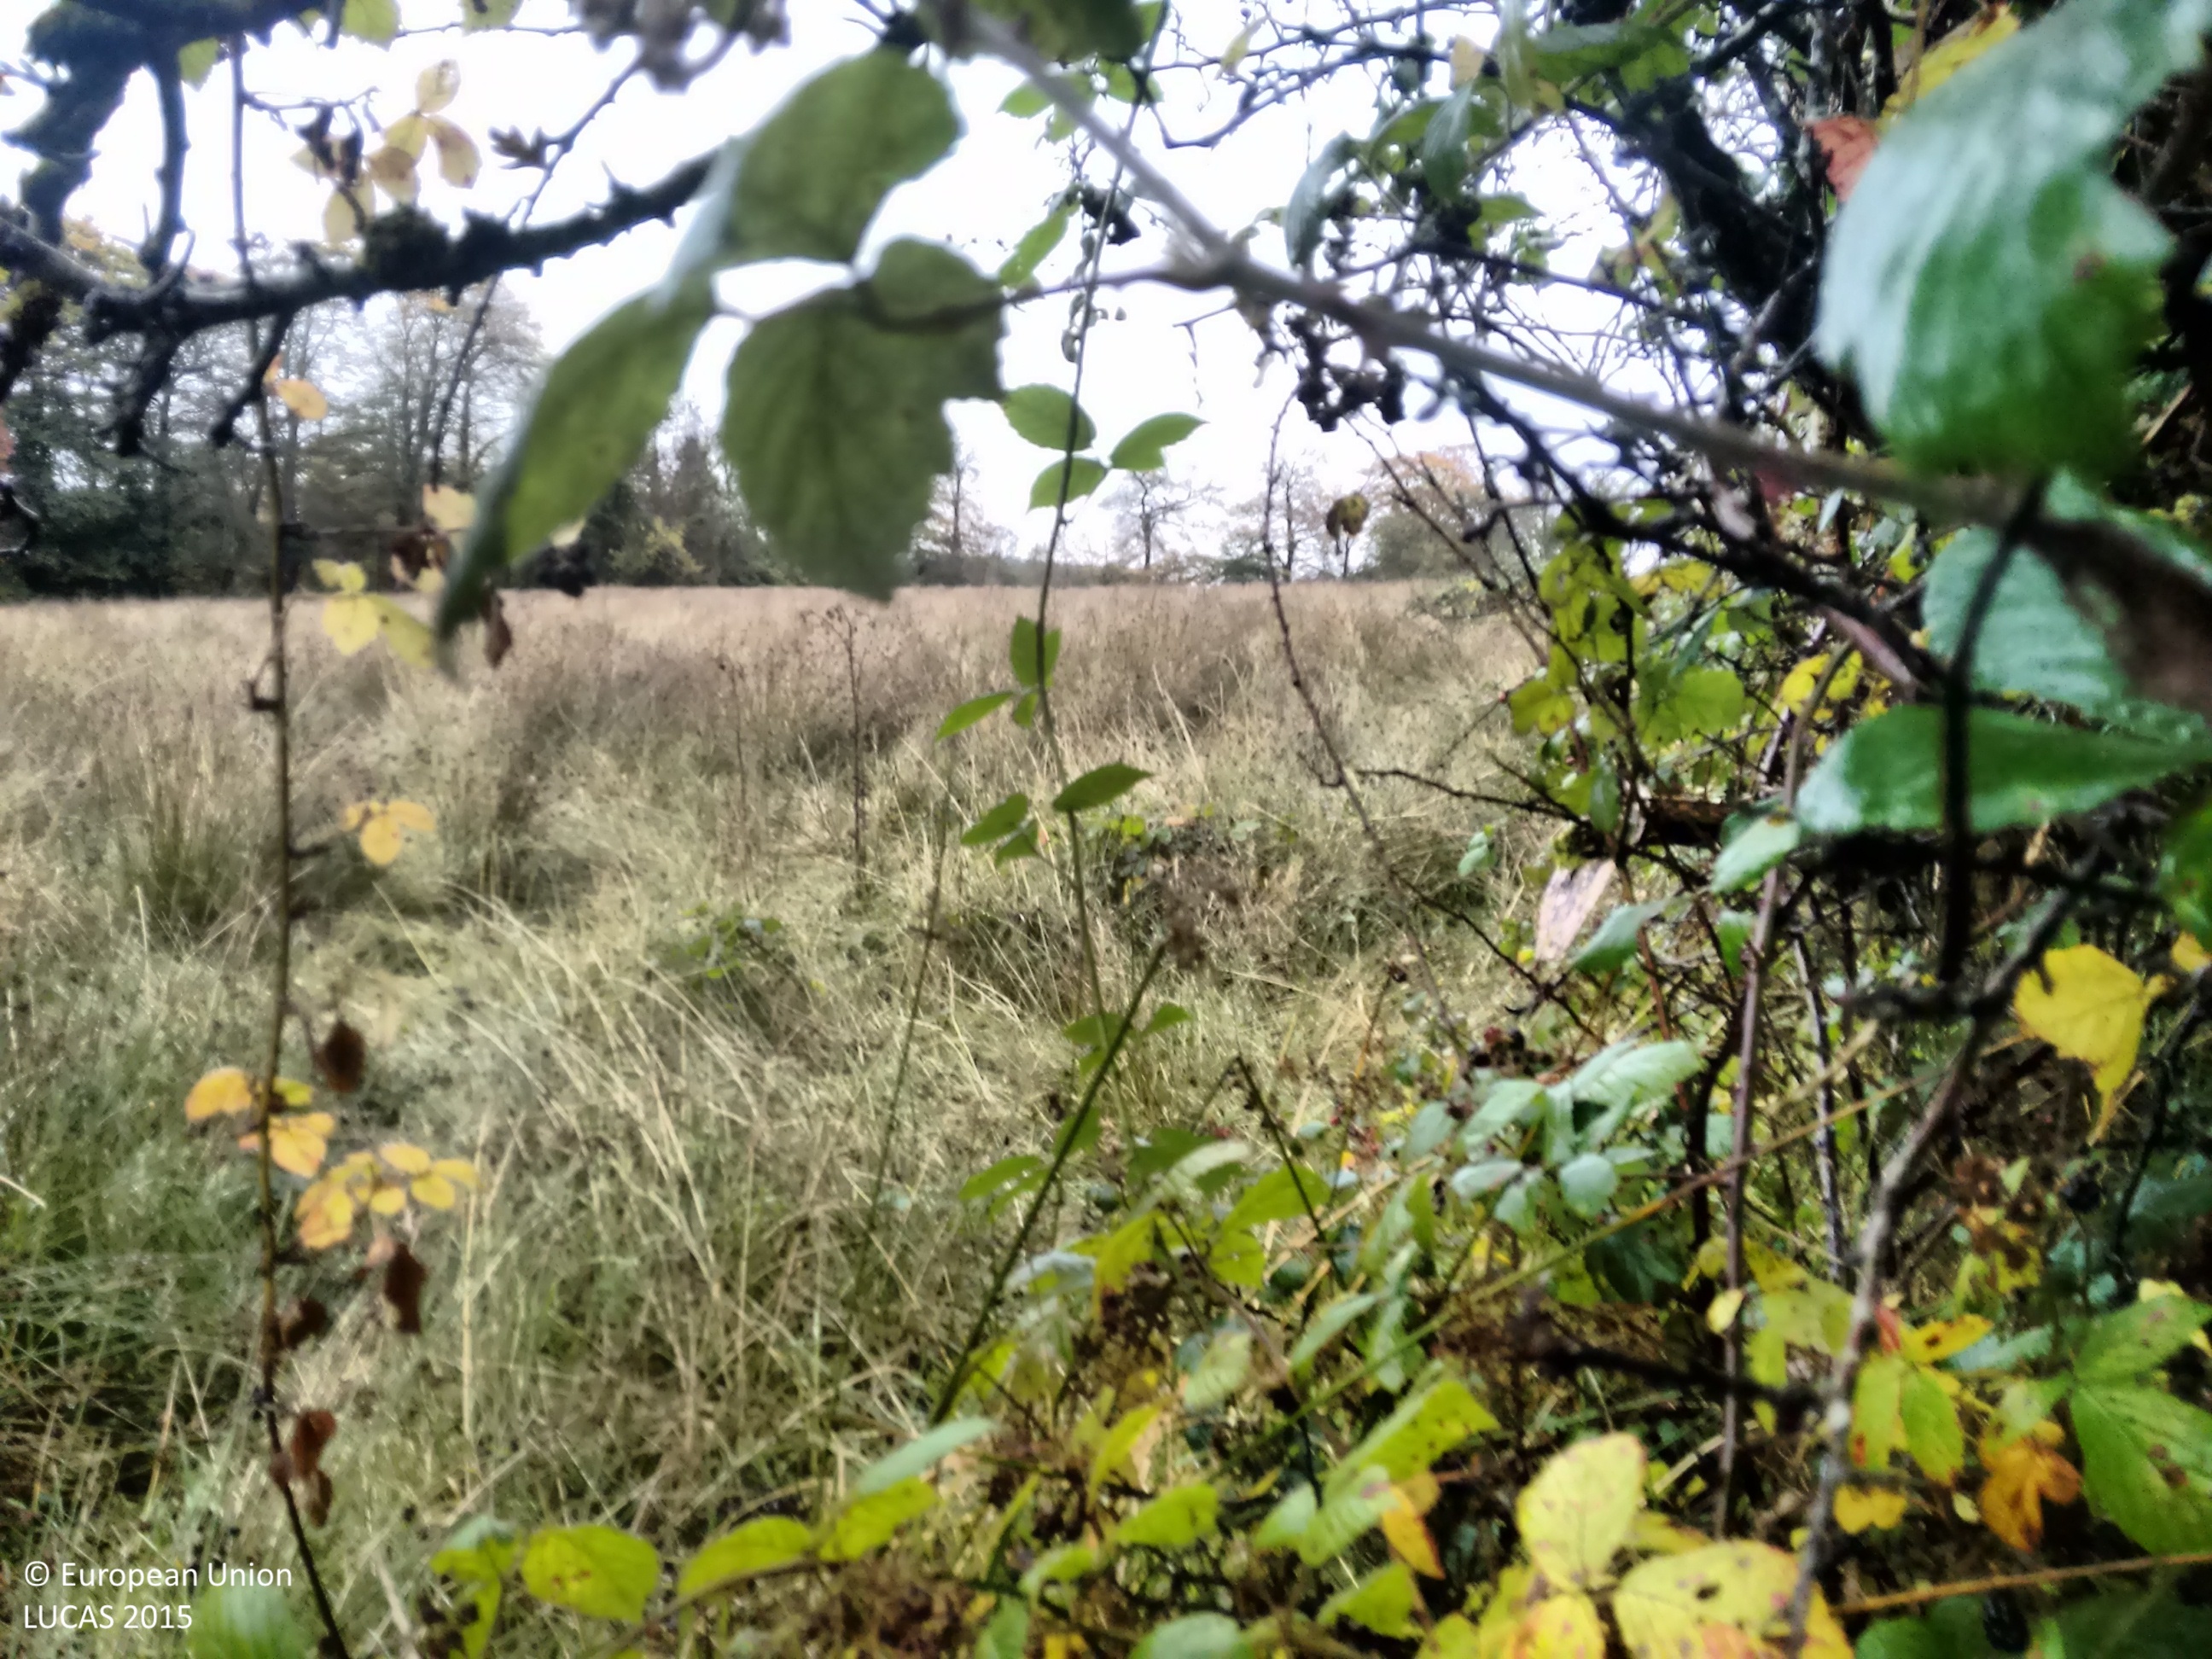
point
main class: Grassland
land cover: Grassland without tree/shrub cover
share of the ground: > 75 %
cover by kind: herbaceous plants 100 %
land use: Agriculture (excluding fallow land and kitchen gardens)
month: October
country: IE
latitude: 53.8704
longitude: -8.0775
